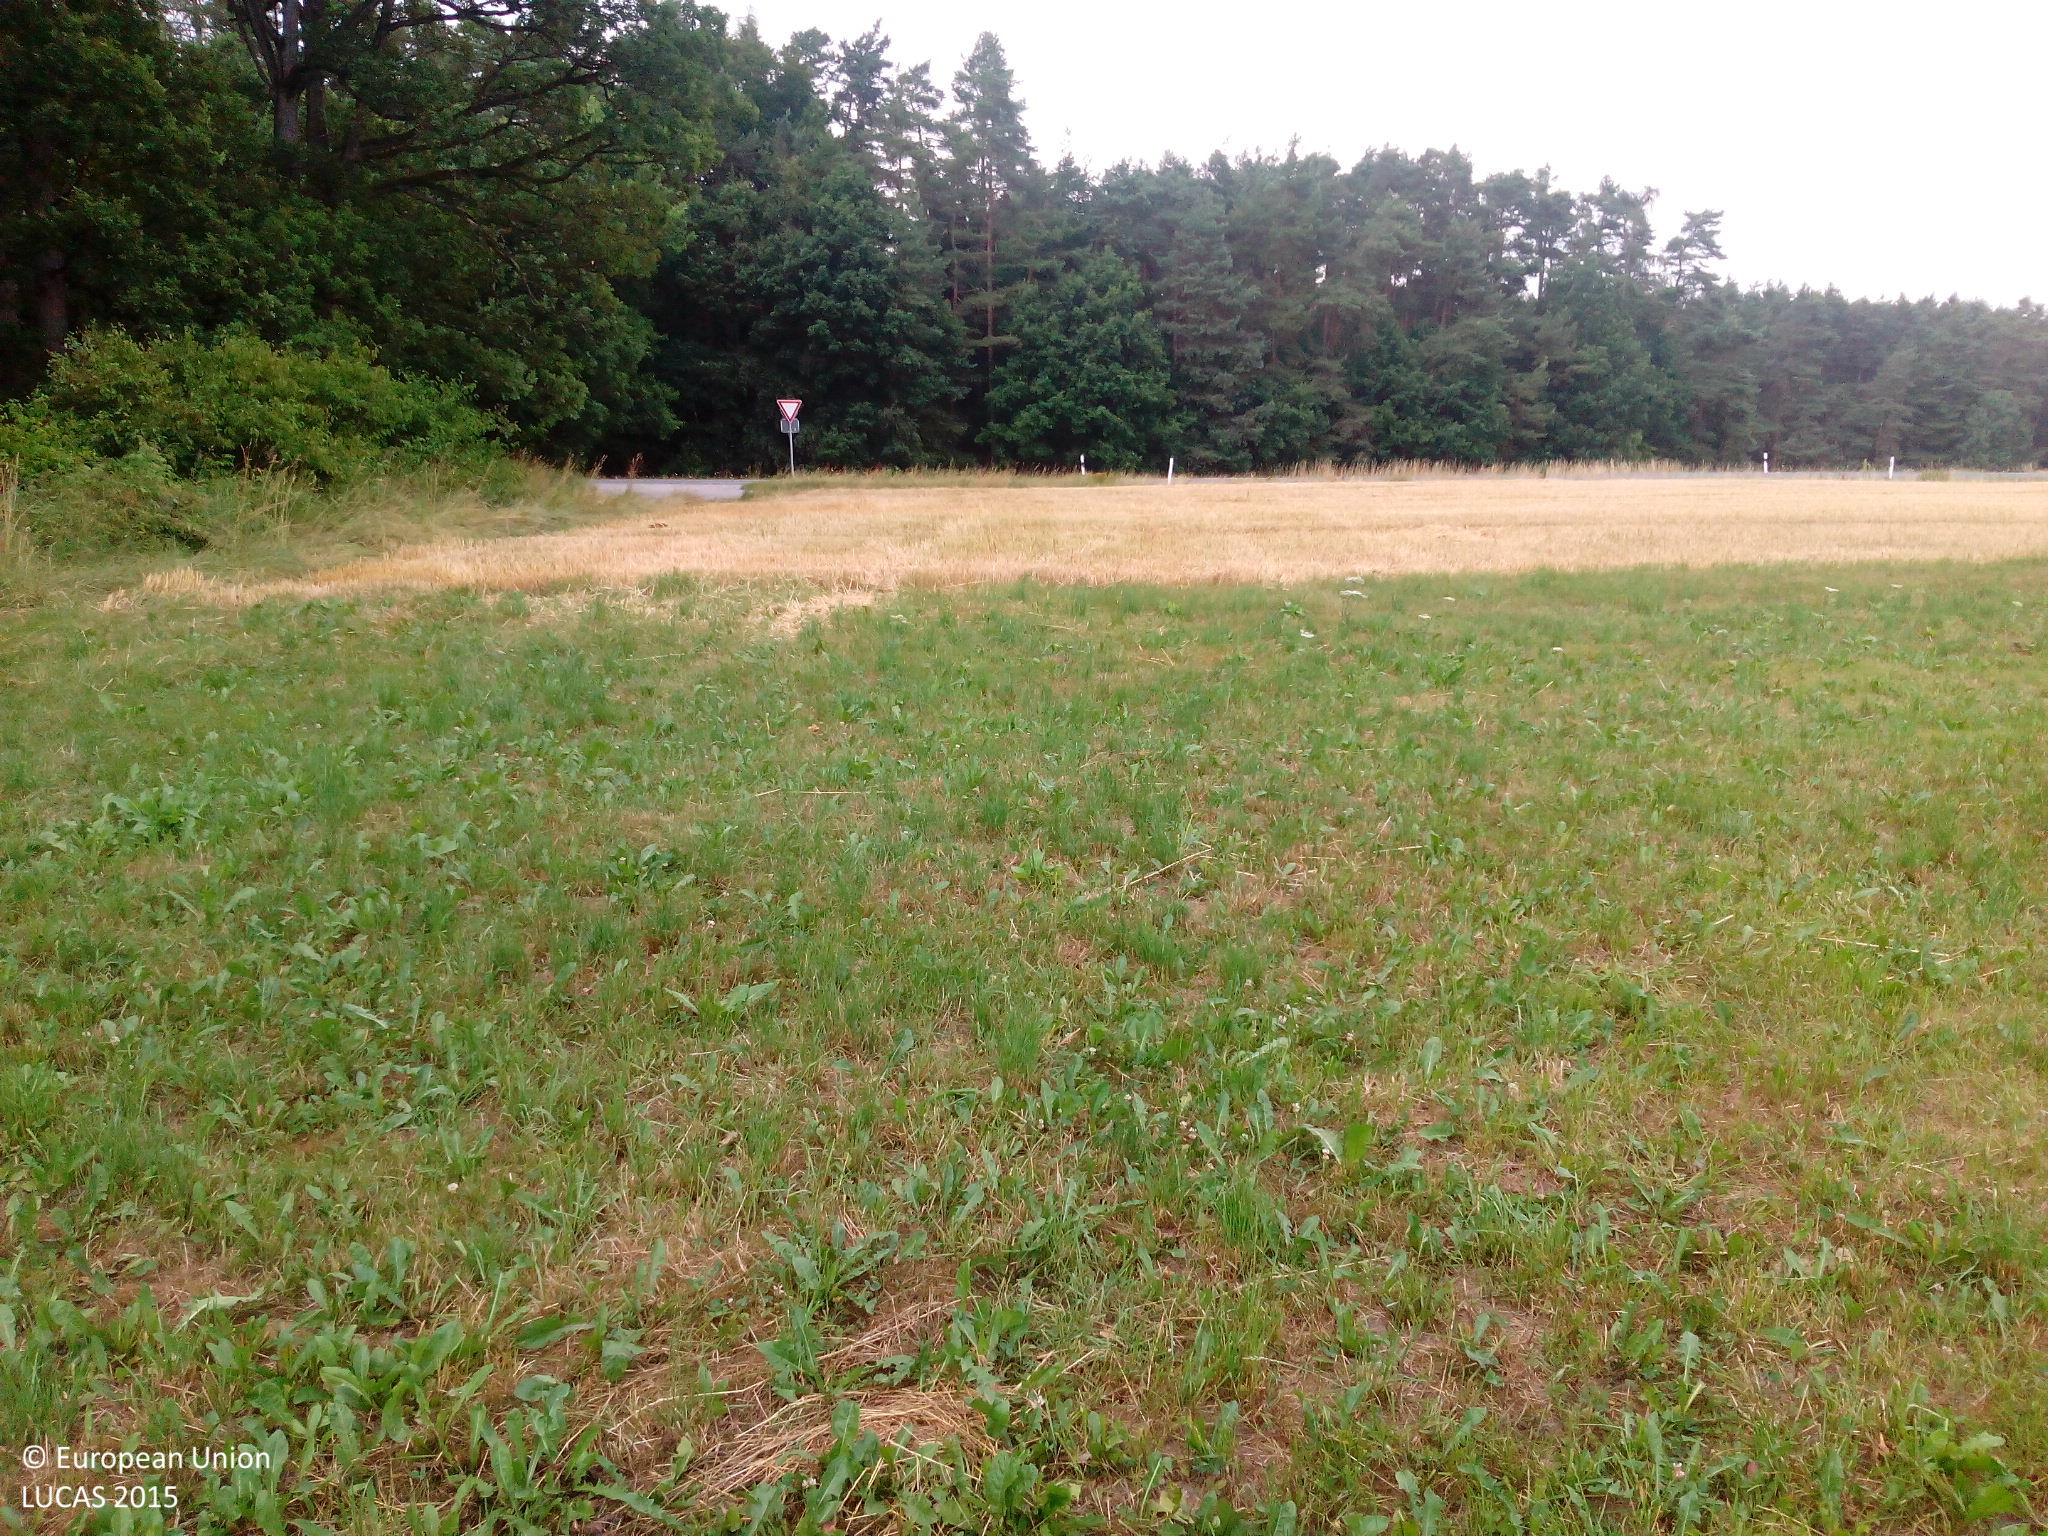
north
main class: Grassland
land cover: Grassland without tree/shrub cover
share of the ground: > 75 %
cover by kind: herbaceous plants 100 %
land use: Agriculture (excluding fallow land and kitchen gardens)
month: July
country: DE
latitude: 49.4994
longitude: 10.5659
